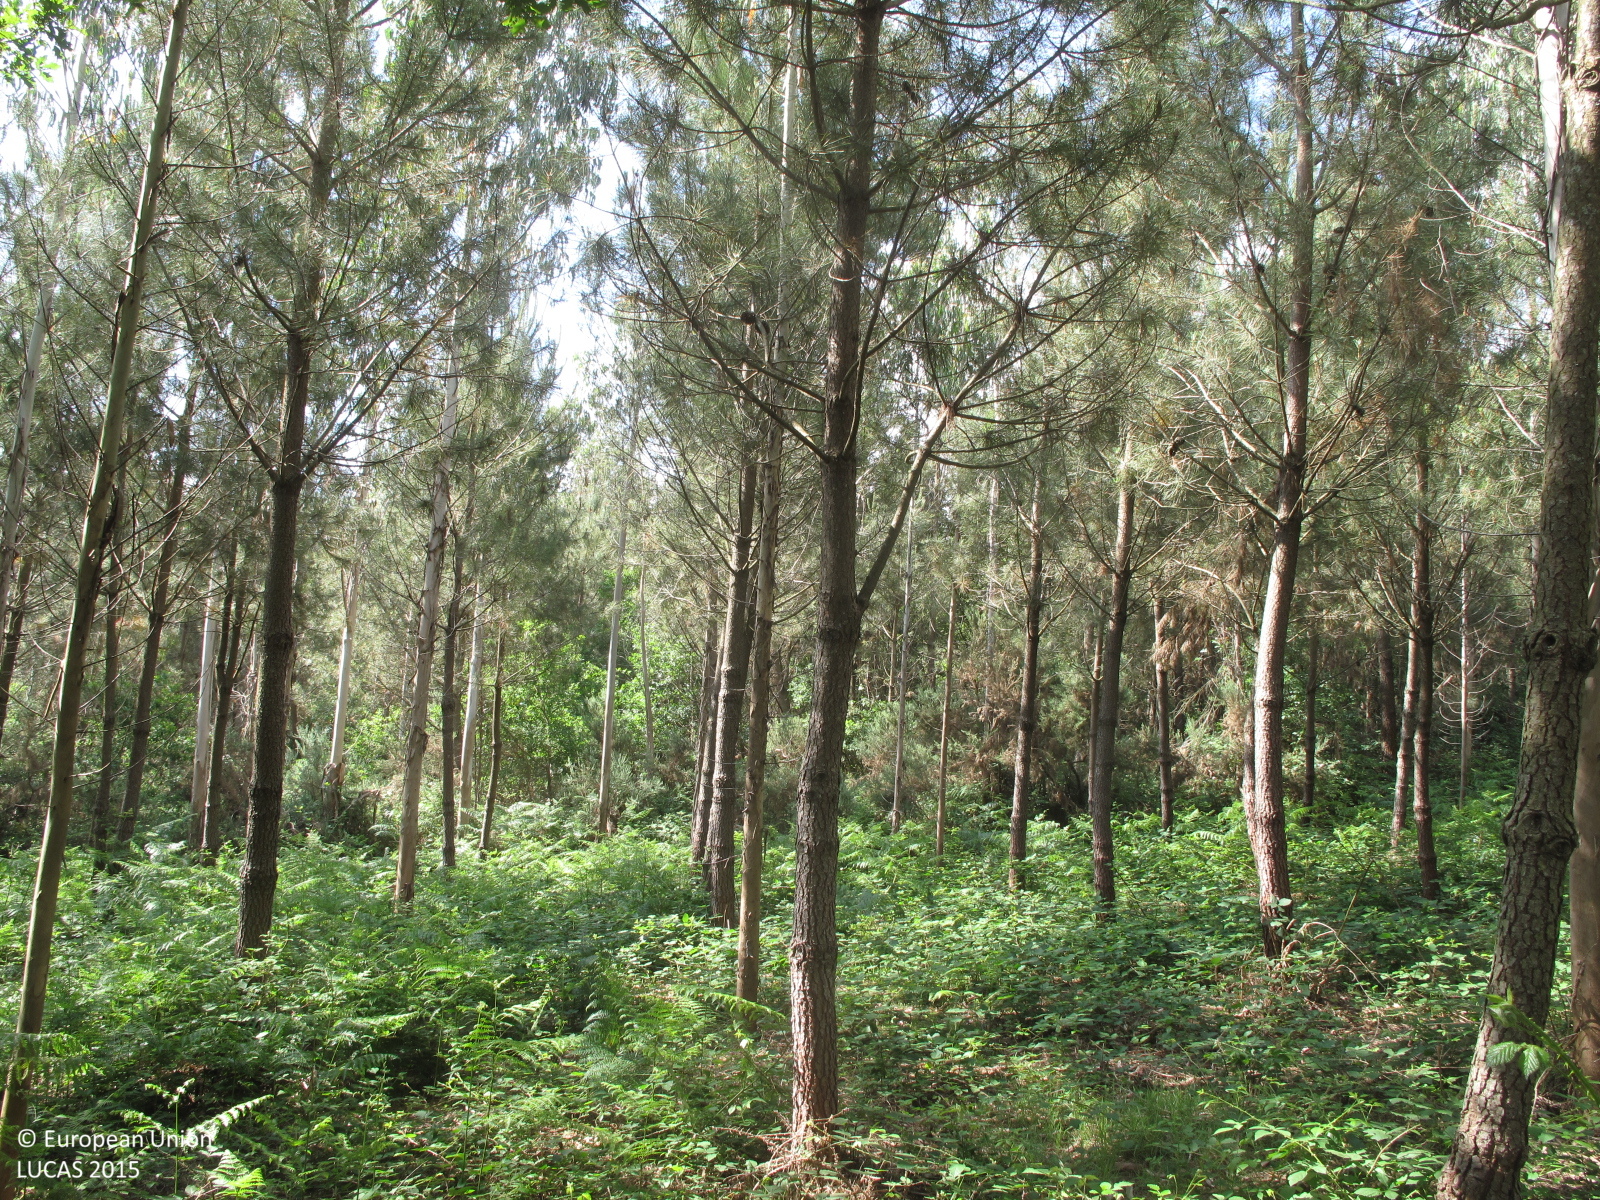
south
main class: Woodland
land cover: Other mixed woodland
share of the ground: > 75 %
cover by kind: coniferous forest trees 50 %, broadleaved forest trees 40 %, shrubs 10 %
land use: Forestry
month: June
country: ES
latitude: 42.9809
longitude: -8.5118
